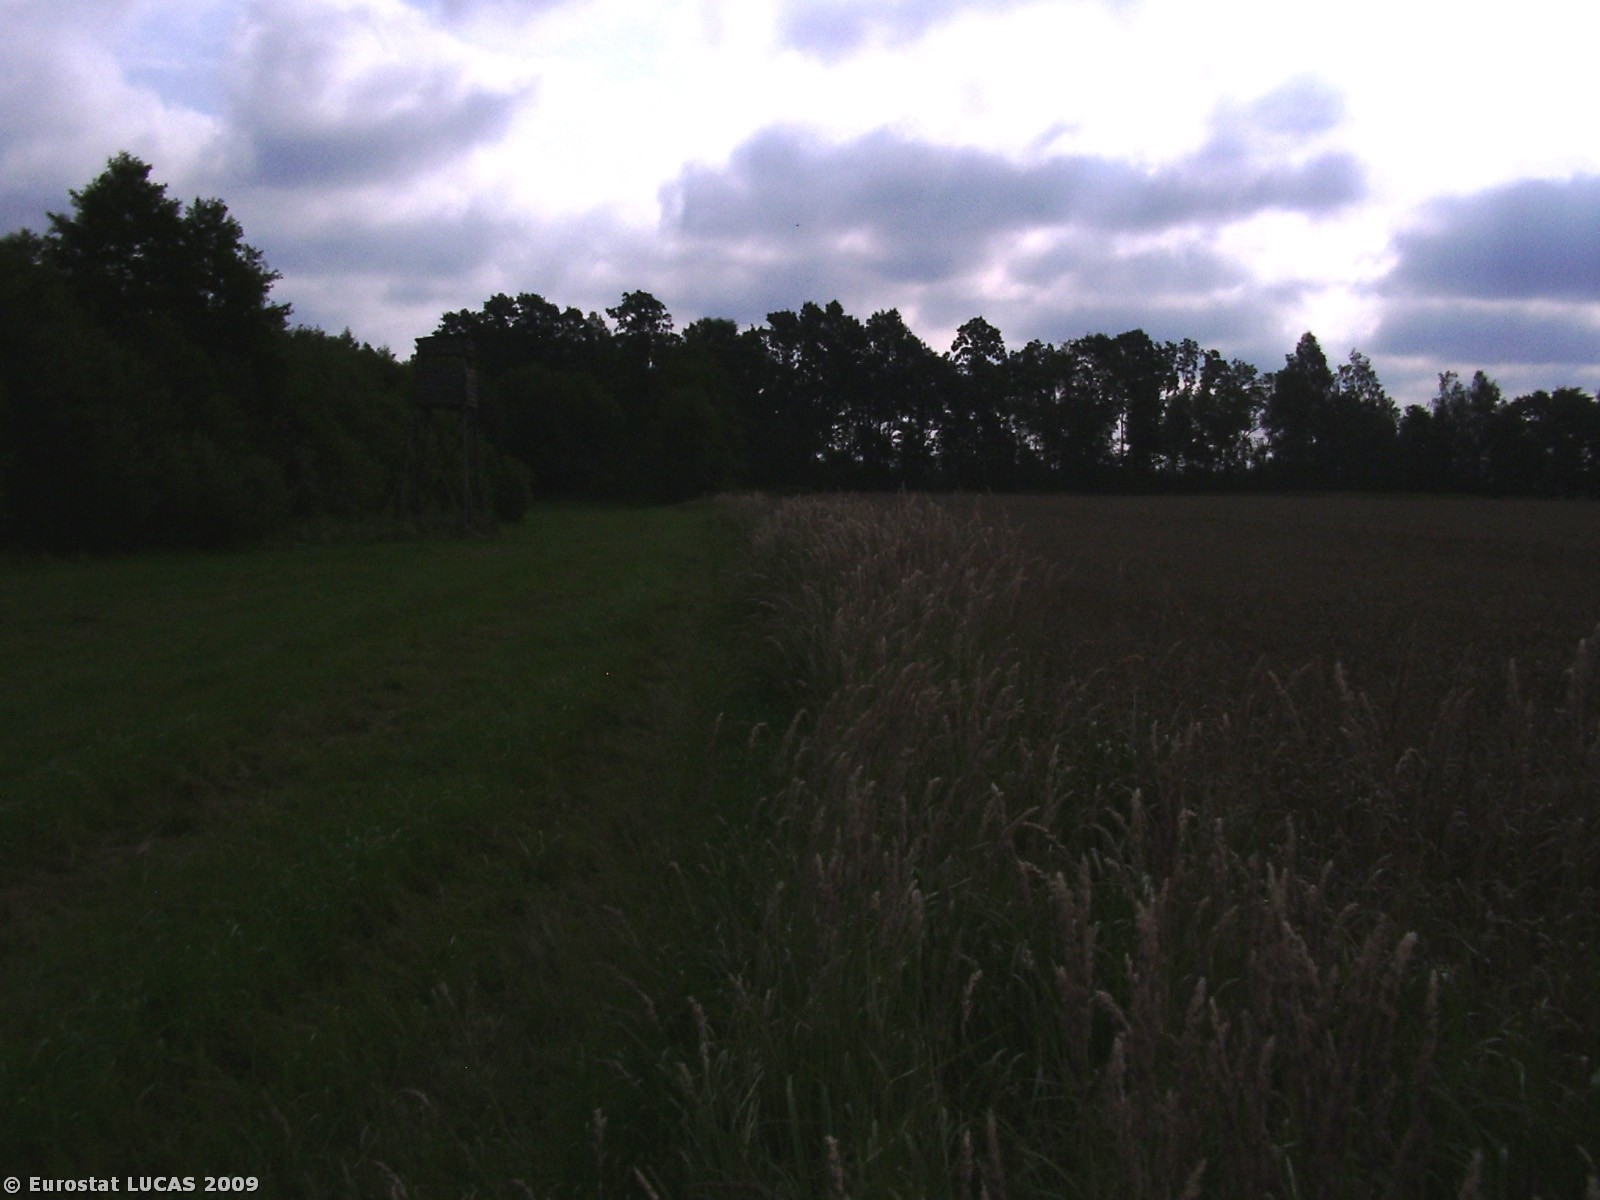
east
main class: Cropland
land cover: Common wheat
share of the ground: > 75 %
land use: Agriculture (excluding fallow land and kitchen gardens)
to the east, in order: Common wheat; Tracks; Broadleaved woodland; Spontaneously vegetated surfaces
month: May
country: PL
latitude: 51.5118
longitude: 16.8538
